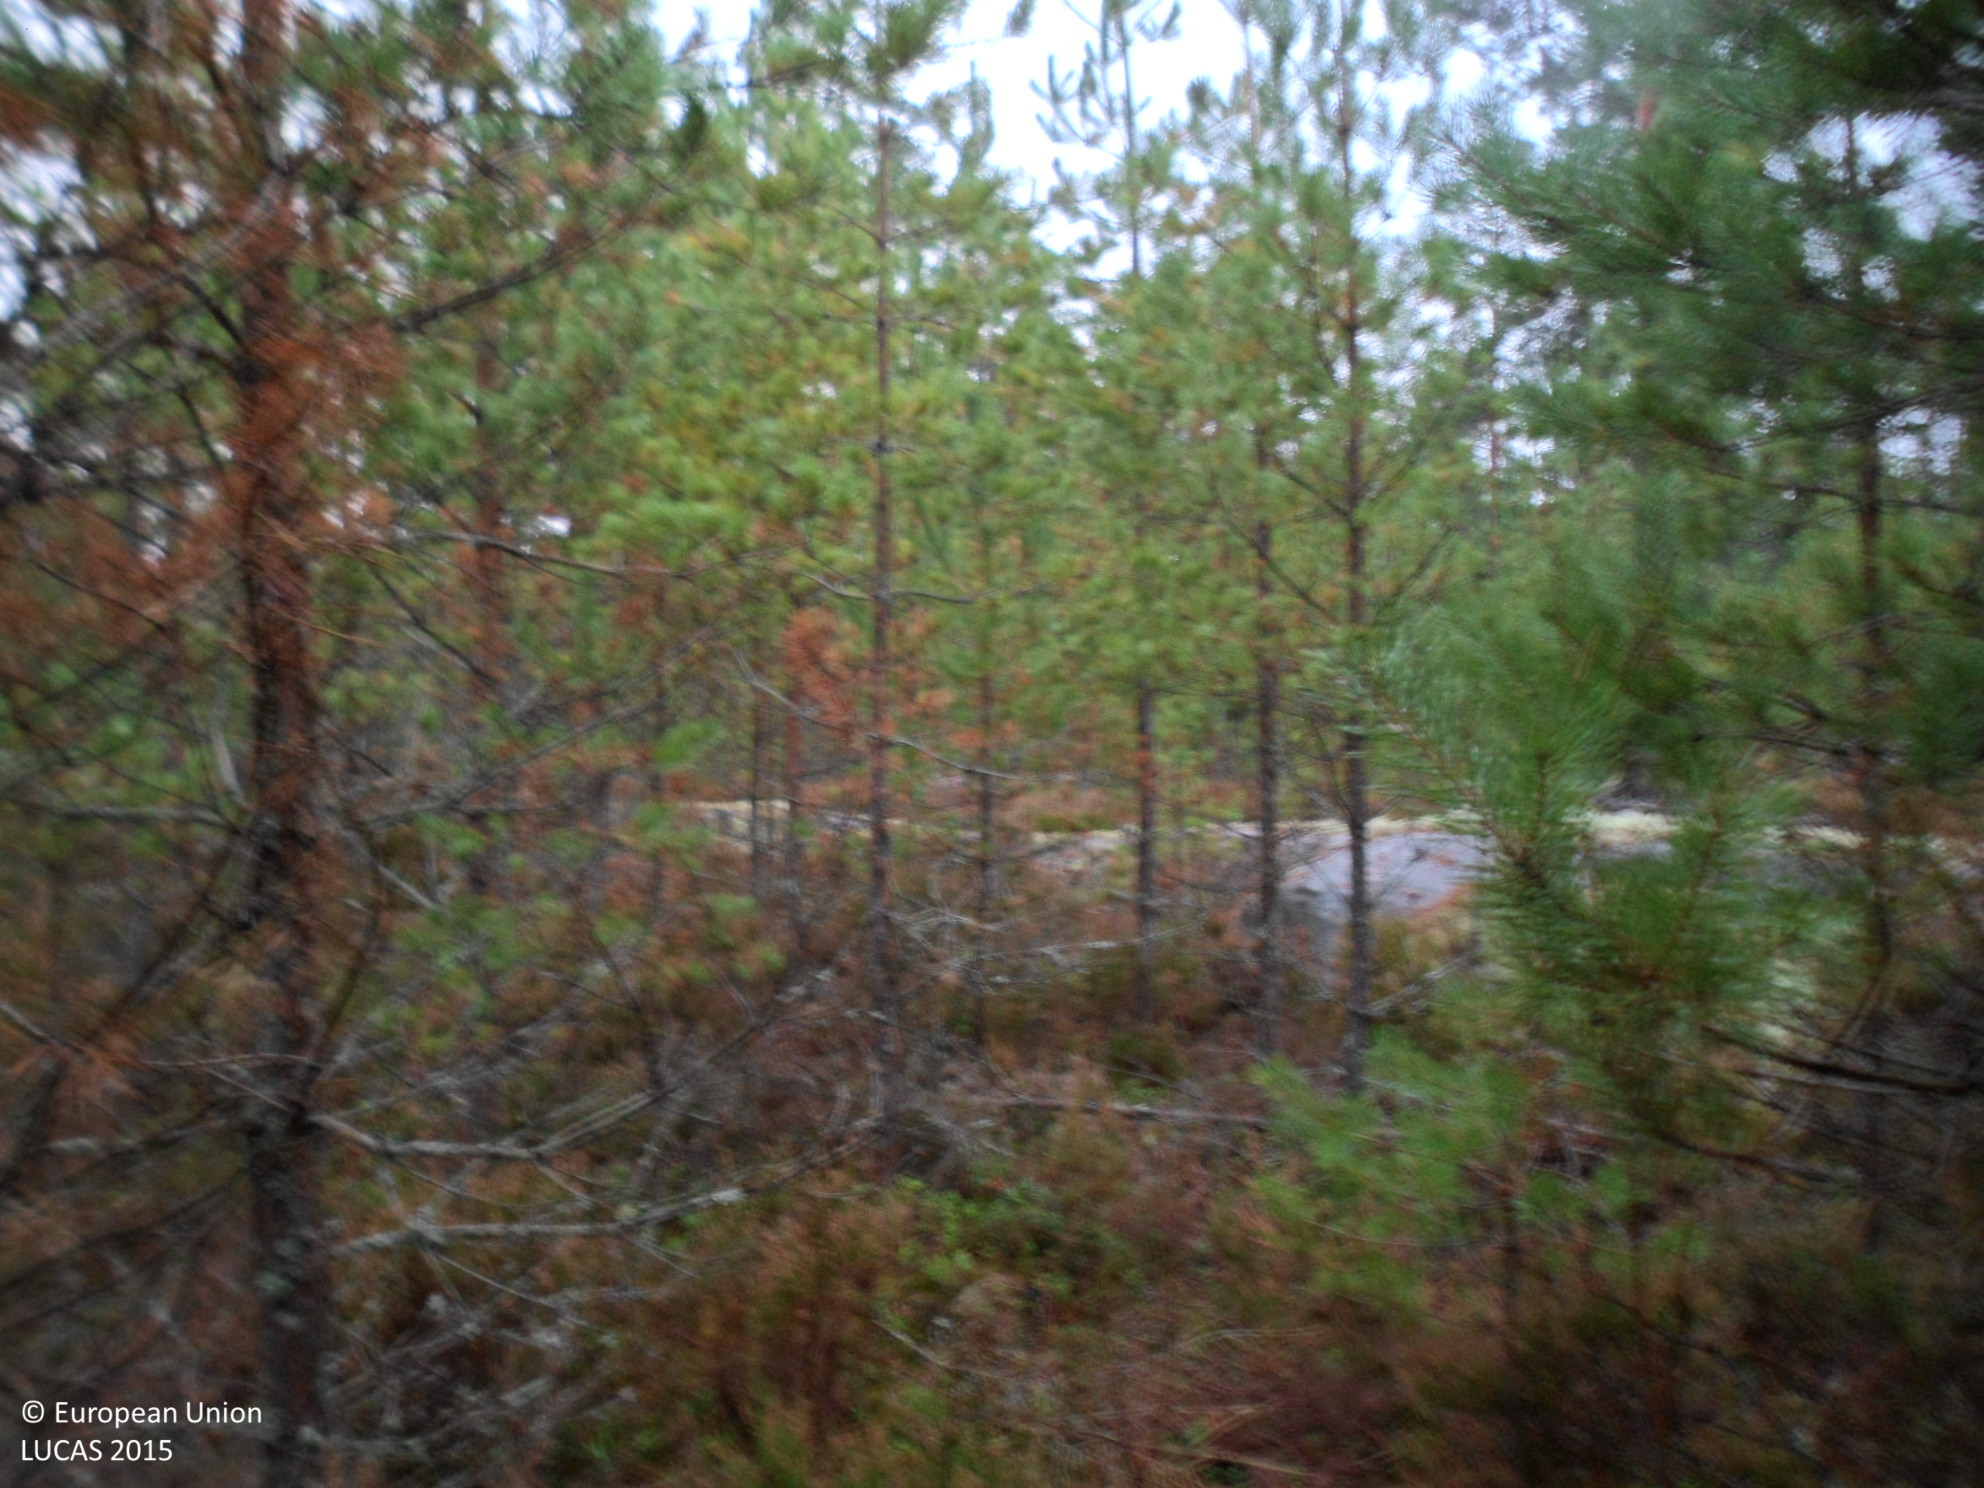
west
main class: Woodland
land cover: Pine dominated coniferous woodland
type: boreal forest
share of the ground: 50 - 75 %
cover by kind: coniferous forest trees 55 %, shrubs 30 %, lichens and mosses 10 %, broadleaved forest trees 5 %
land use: Forestry
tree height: < 5 m
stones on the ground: > 50 %
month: November
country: SE
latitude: 57.0223
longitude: 15.9785
